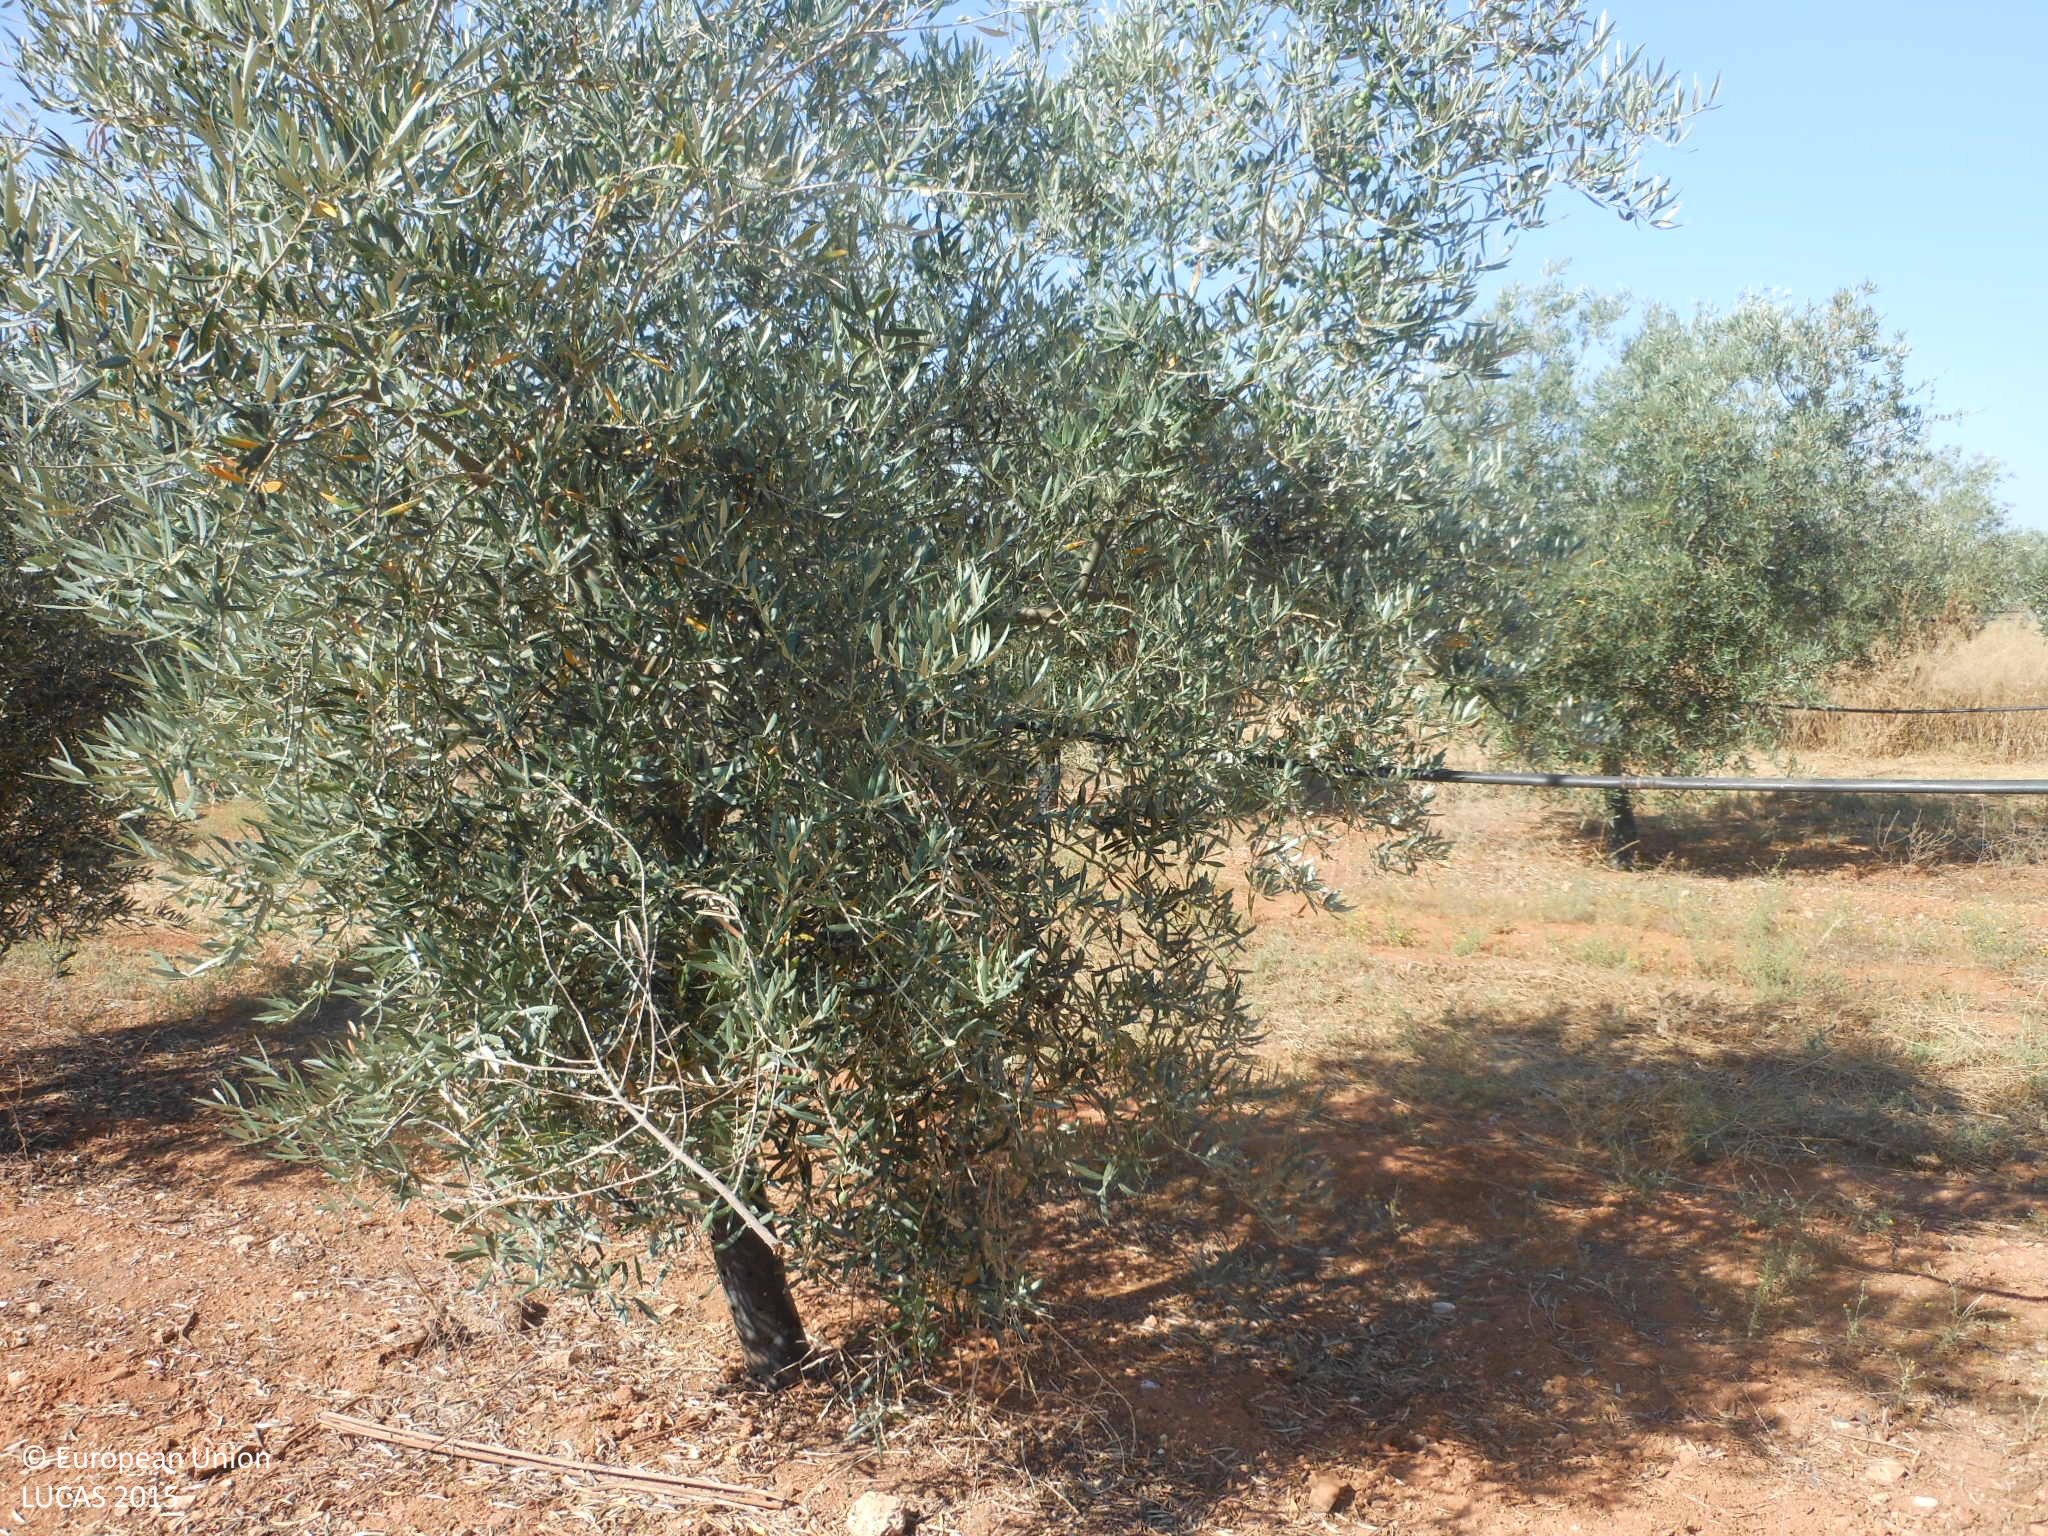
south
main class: Cropland
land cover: Olive groves
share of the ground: 50 - 75 %
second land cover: Spontaneously vegetated surfaces
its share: 25 - 50 %
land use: Agriculture (excluding fallow land and kitchen gardens)
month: June
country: ES
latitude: 37.2228
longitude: -4.8236
